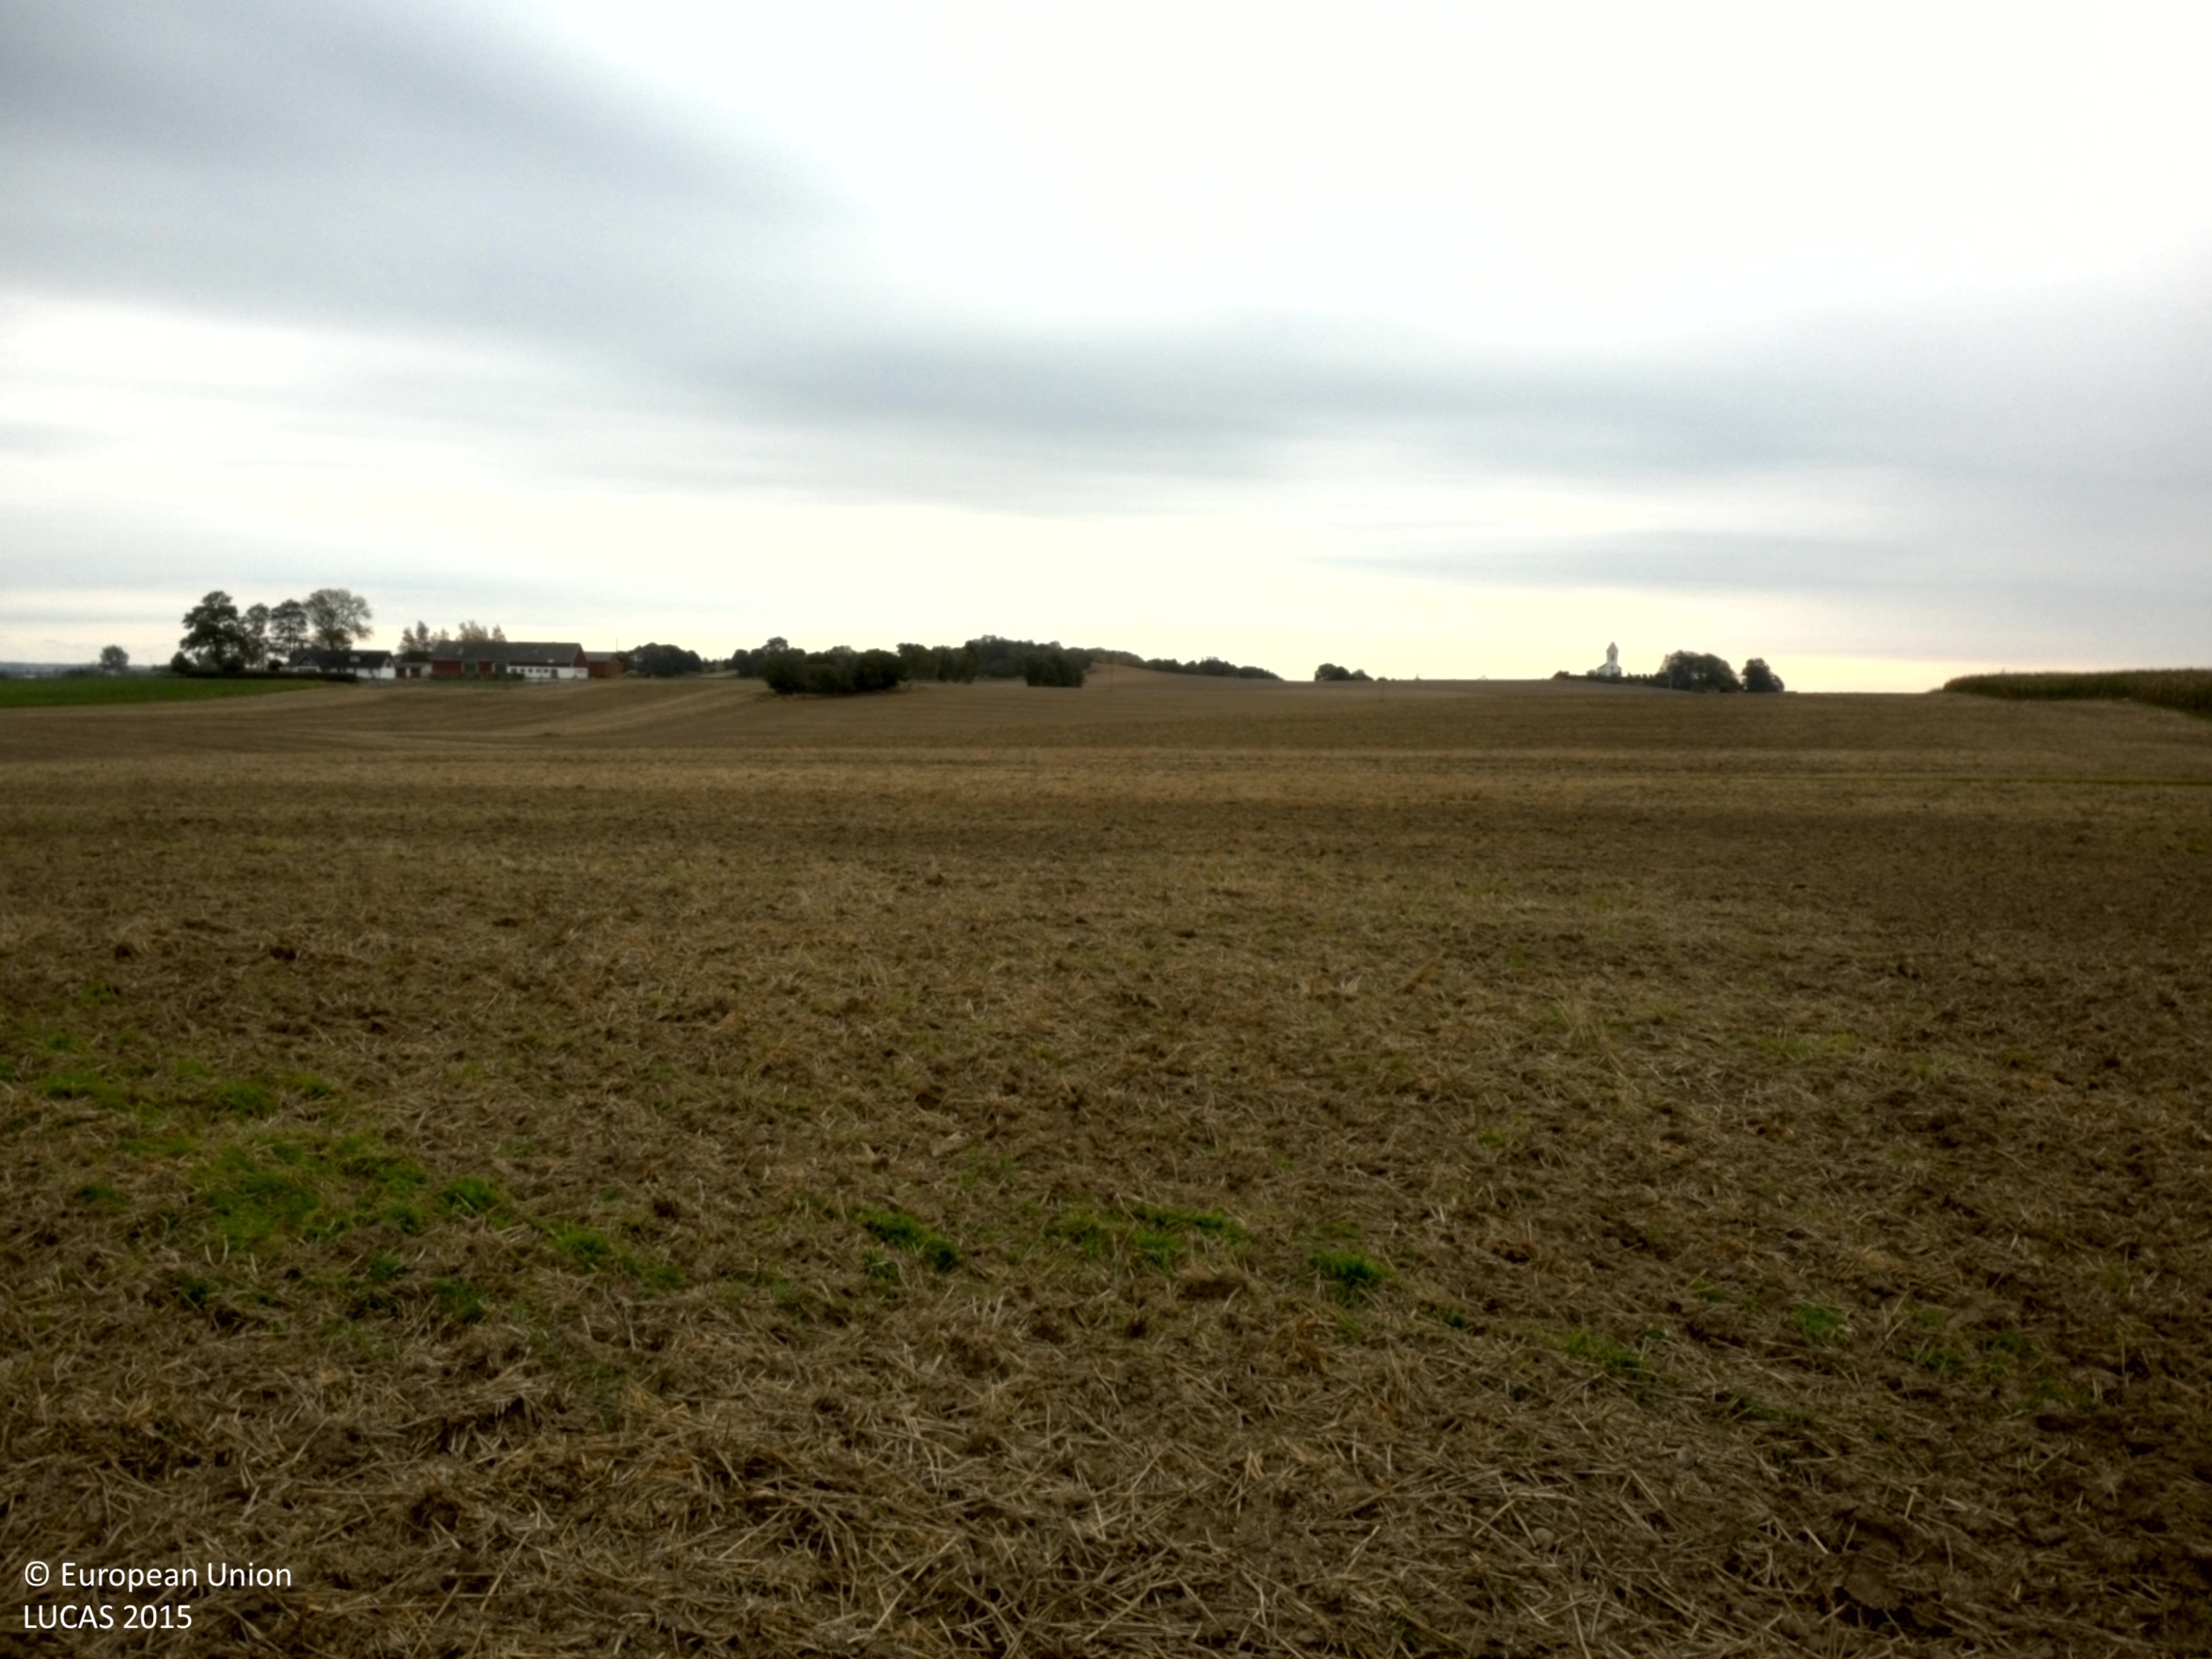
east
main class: Cropland
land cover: Common wheat
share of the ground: < 10 %
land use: Agriculture (excluding fallow land and kitchen gardens)
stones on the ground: < 10 %
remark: Harvested field
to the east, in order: Common wheat; Grass margins; Paved roads, cycling and walking lanes; Common wheat
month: October
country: SE
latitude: 55.8278
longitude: 13.0469
